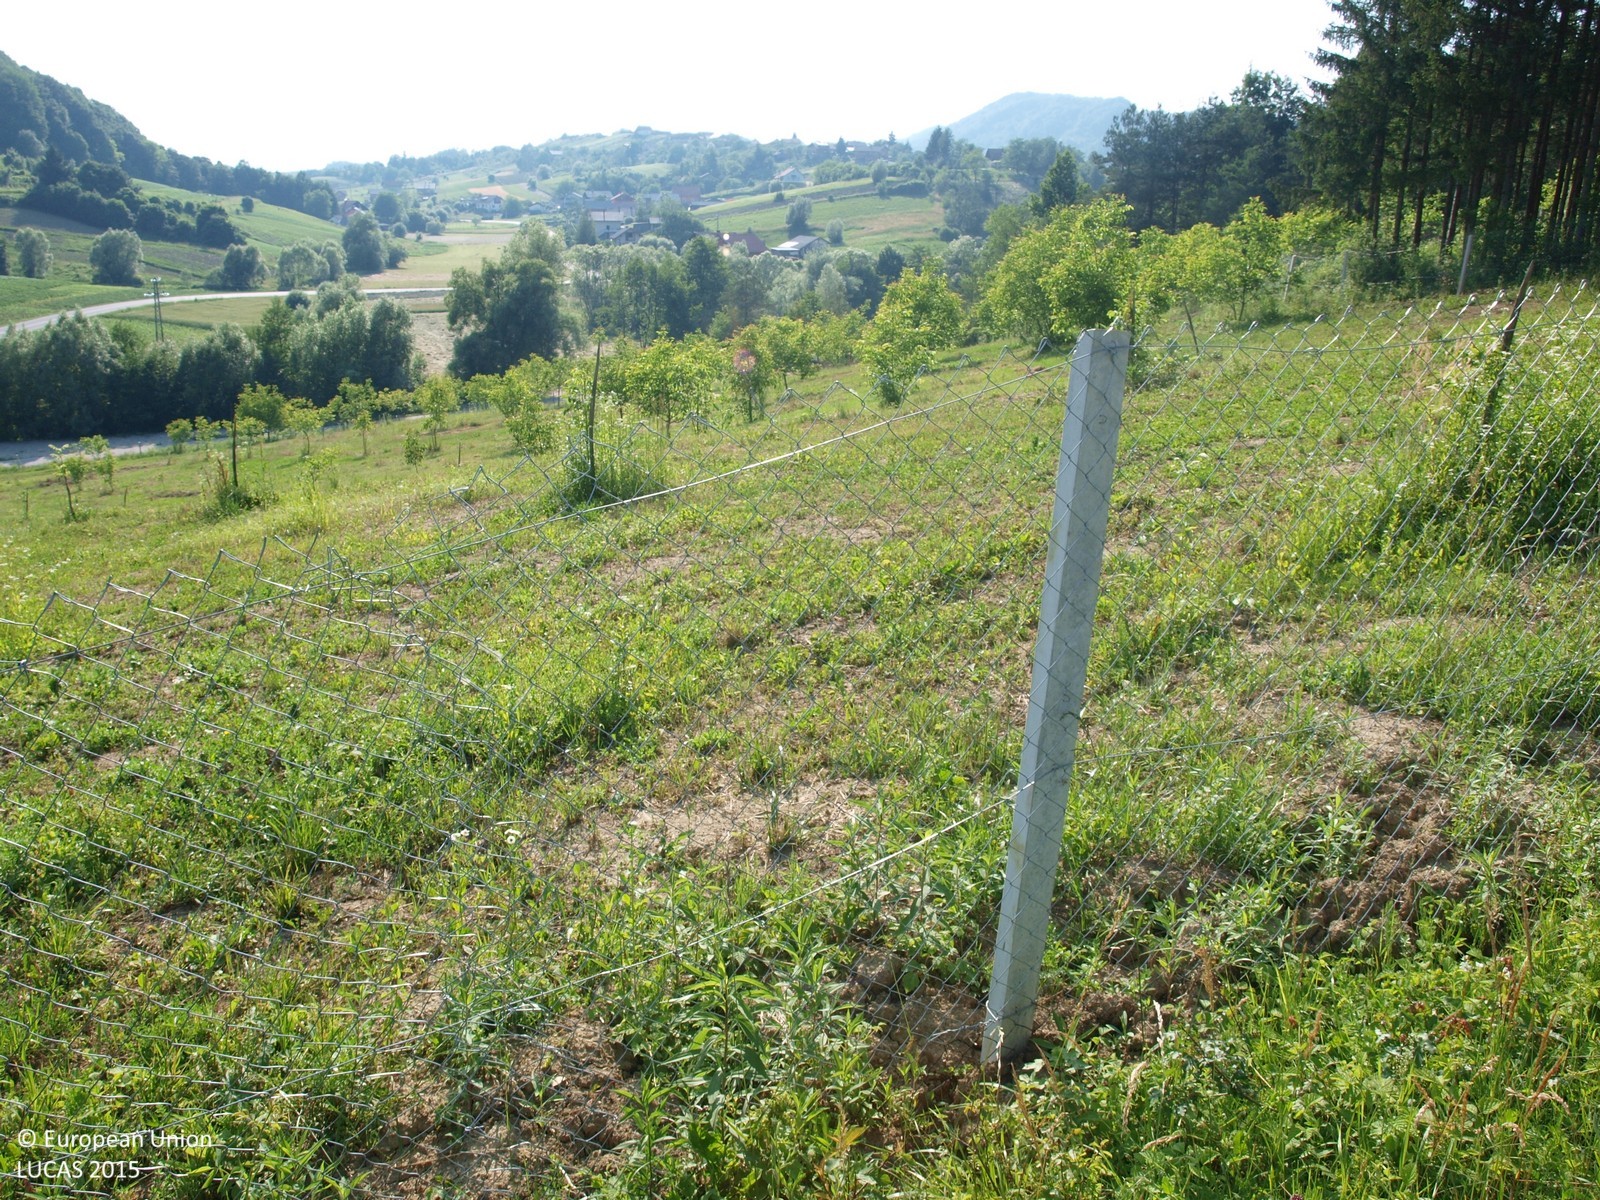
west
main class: Cropland
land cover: Nuts trees
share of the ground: 50 - 75 %
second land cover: Grassland without tree/shrub cover
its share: 50 - 75 %
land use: Agriculture (excluding fallow land and kitchen gardens)
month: June
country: HR
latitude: 46.2906
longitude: 16.0092
